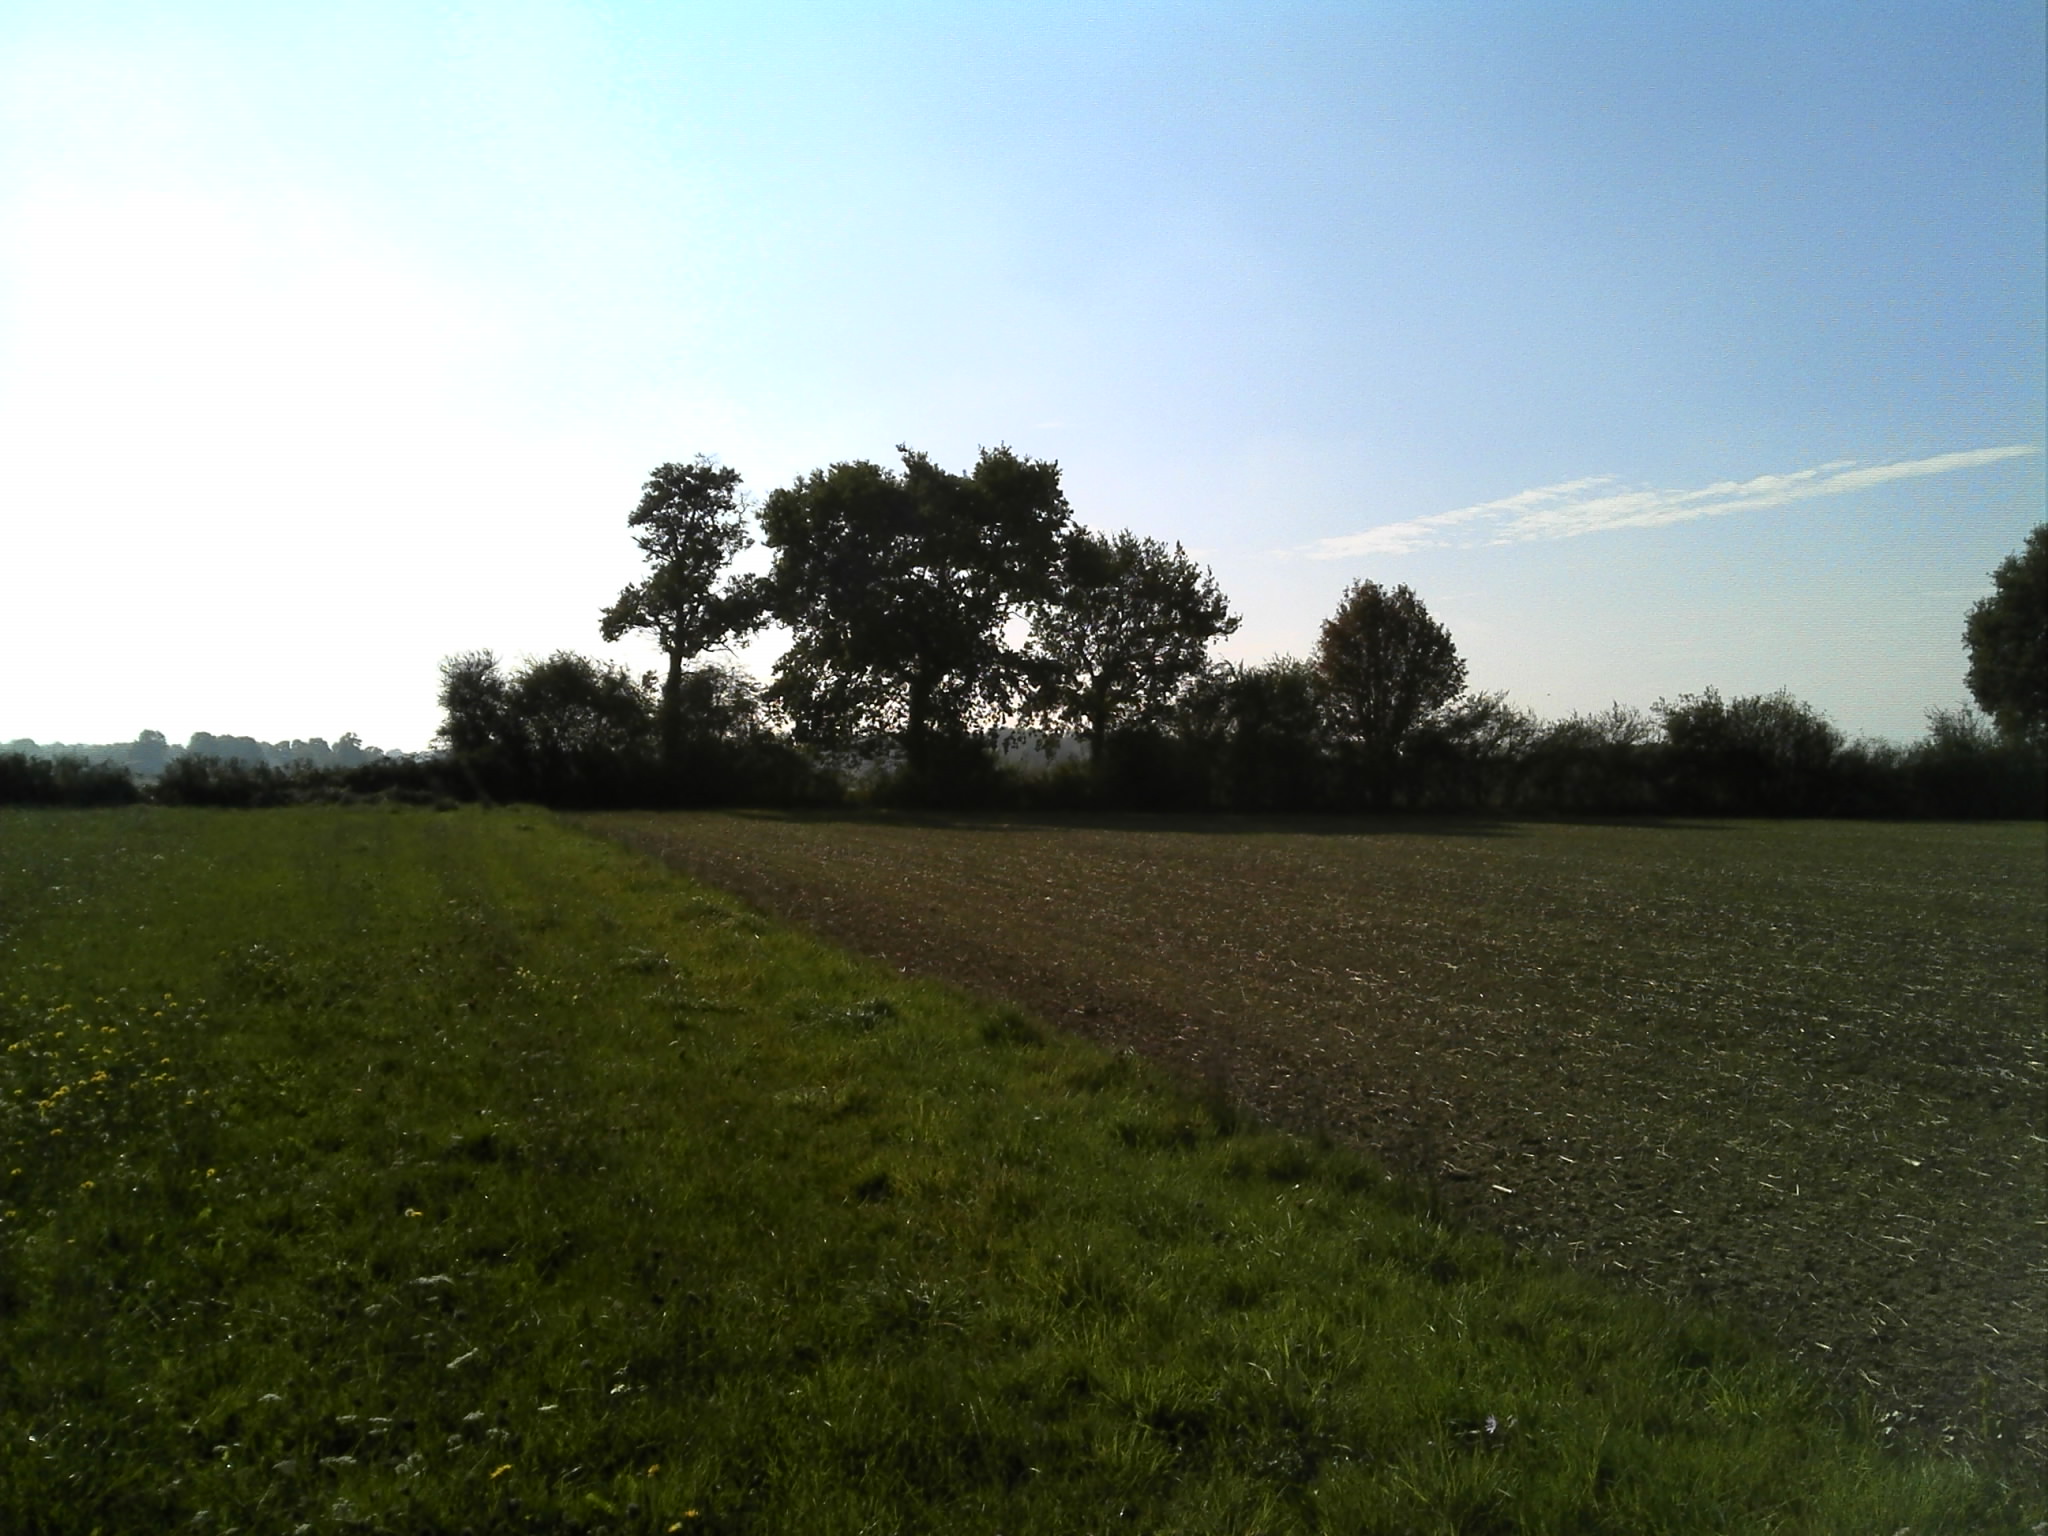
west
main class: Cropland
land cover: Temporary grasslands
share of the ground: > 75 %
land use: Agriculture (excluding fallow land and kitchen gardens)
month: October
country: FR
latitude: 47.2626
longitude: -0.9112
